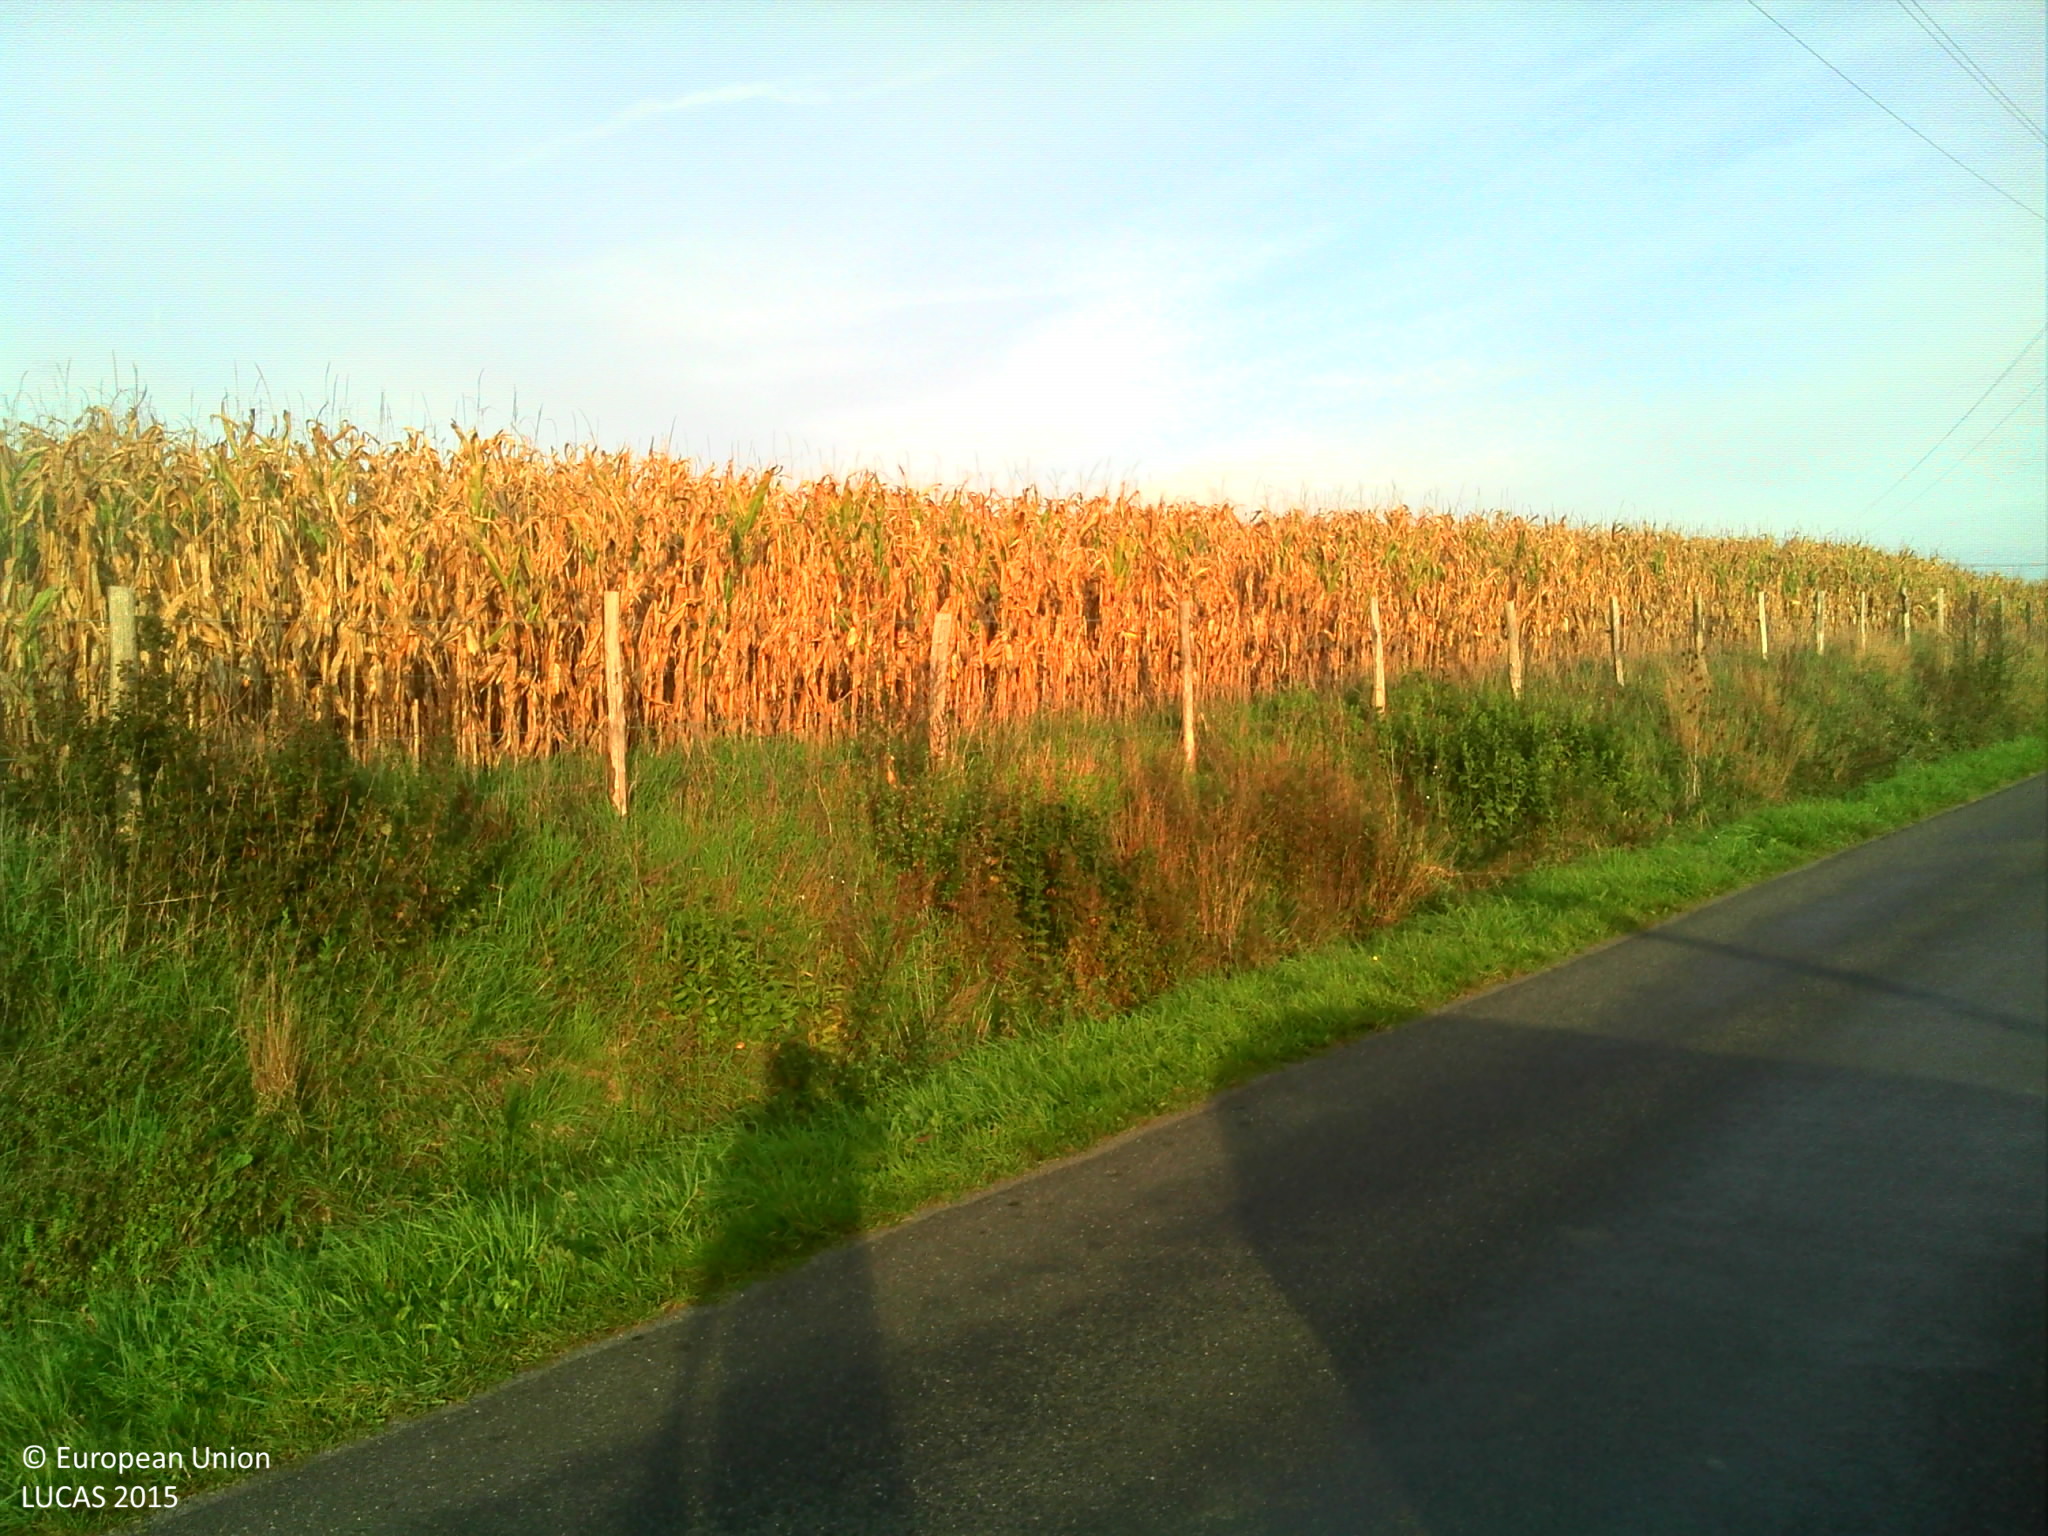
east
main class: Cropland
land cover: Maize
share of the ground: > 75 %
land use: Agriculture (excluding fallow land and kitchen gardens)
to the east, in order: Maize; Fences; Electric lines; Ditches and canals; Grass margins; Paved roads, cycling and walking lanes; Grass margins; Ditches and canals; Fences; Grassland without tree/shrub cover
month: October
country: FR
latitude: 47.1033
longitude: -1.2243
